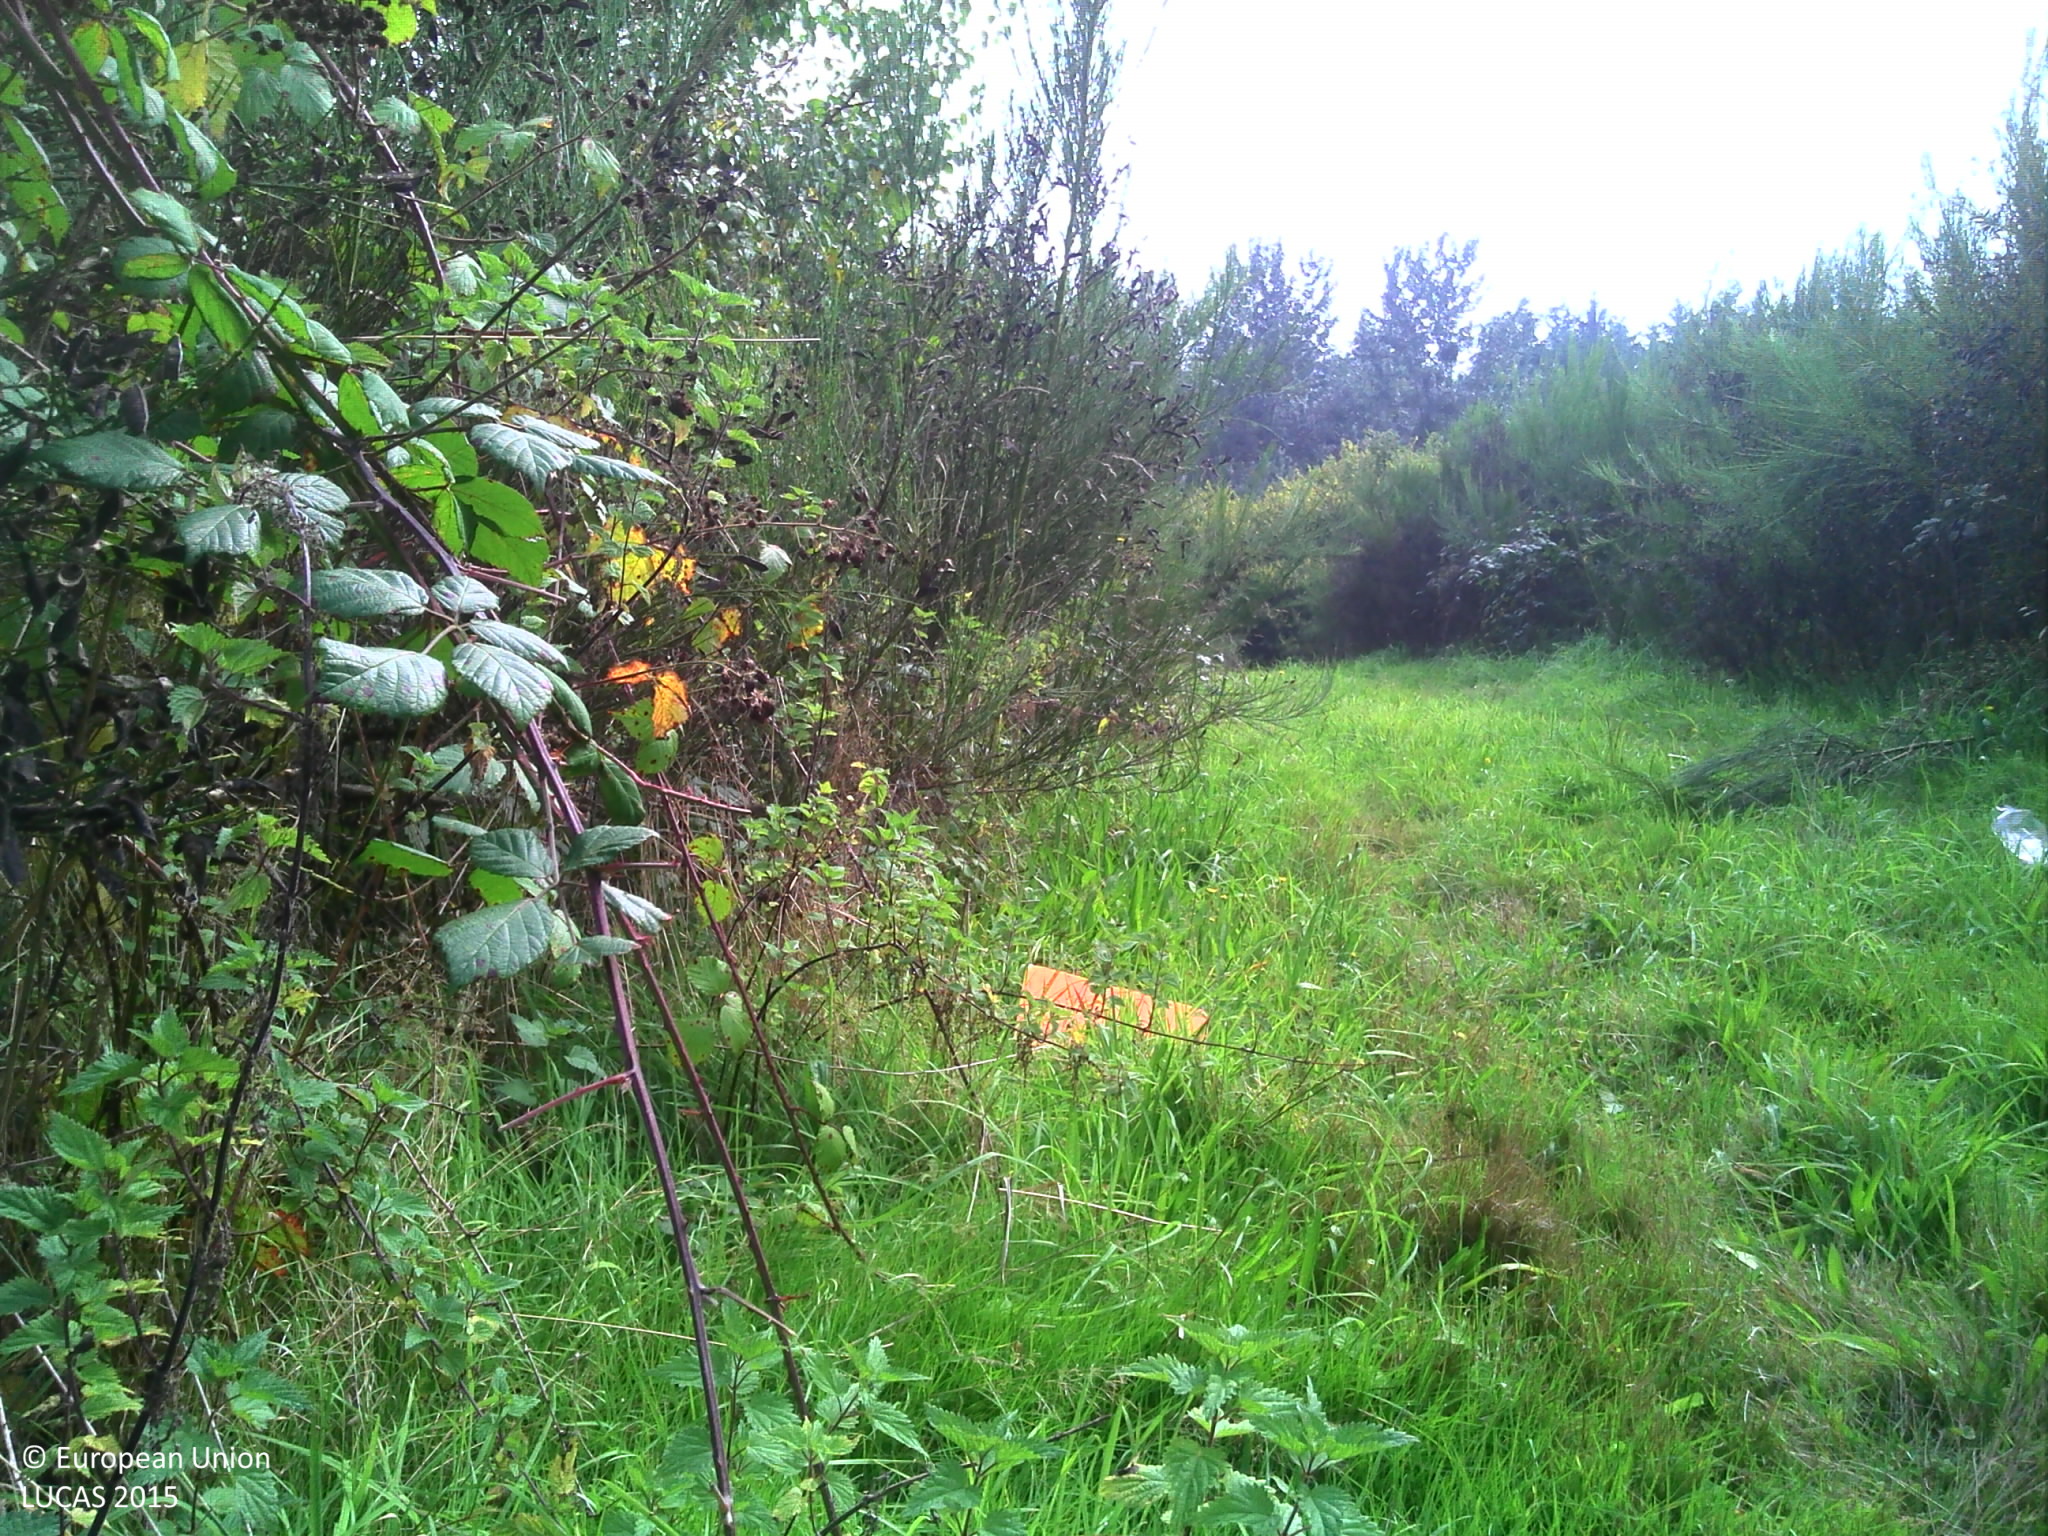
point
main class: Shrubland
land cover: Shrubland without tree cover
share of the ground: > 75 %
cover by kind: shrubs 100 %
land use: Semi-natural and natural areas not in use
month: October
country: FR
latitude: 48.5089
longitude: -3.1347
